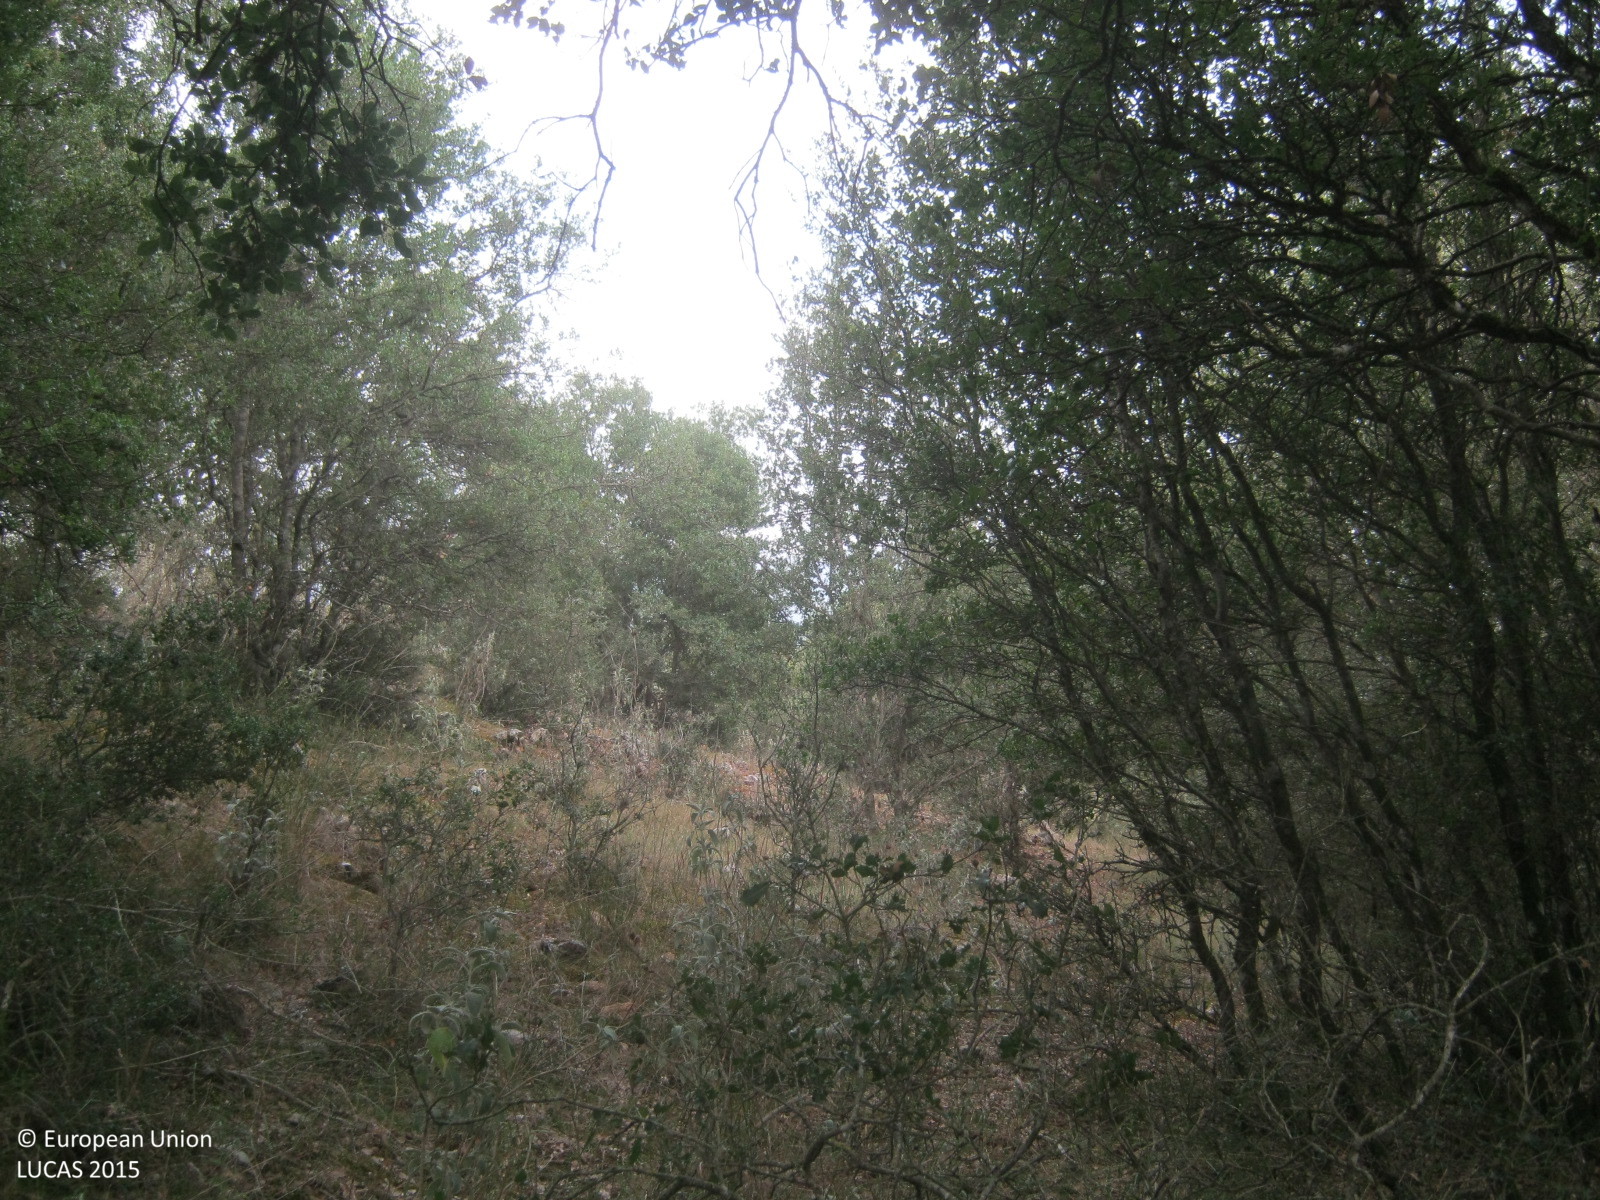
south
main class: Woodland
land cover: Broadleaved woodland
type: broadleaved evergreen forest
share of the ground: 50 - 75 %
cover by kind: broadleaved forest trees 65 %, shrubs 20 %, herbaceous plants 10 %, unconsolidated bare surface 5 %
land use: Semi-natural and natural areas not in use
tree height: > 5 m
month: September
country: GR
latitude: 37.8012
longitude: 22.0593
